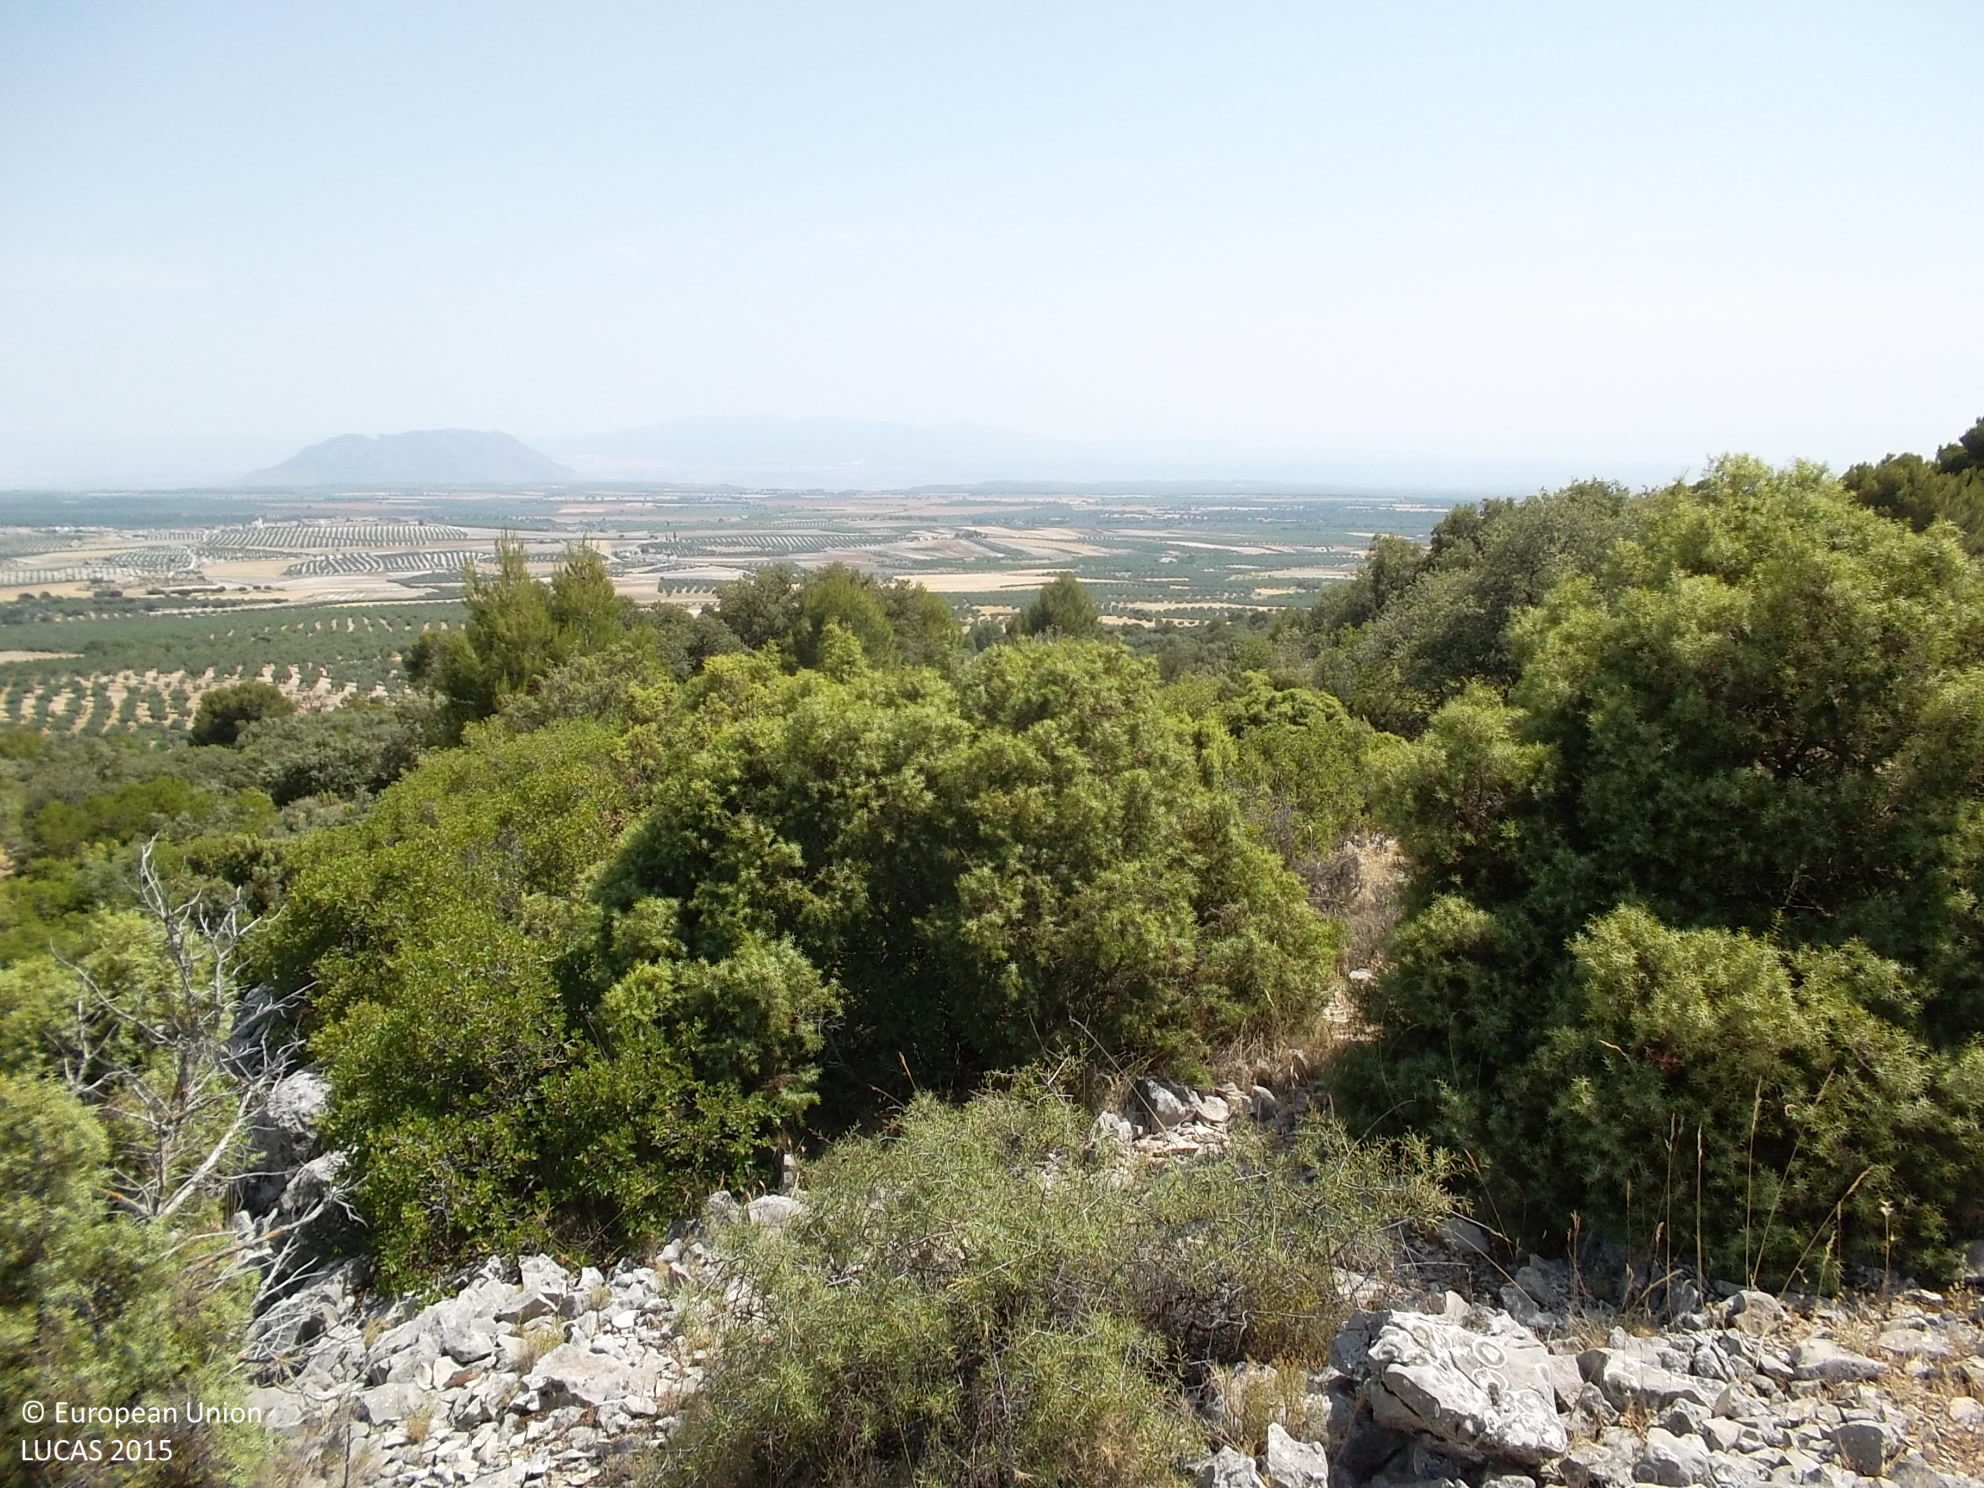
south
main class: Shrubland
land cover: Shrubland with sparse tree cover
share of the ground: 50 - 75 %
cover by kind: consolidated bare surface 60 %, shrubs 35 %, broadleaved forest trees 5 %
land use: Semi-natural and natural areas not in use
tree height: < 5 m
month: June
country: ES
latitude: 37.7666
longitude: -2.8765
